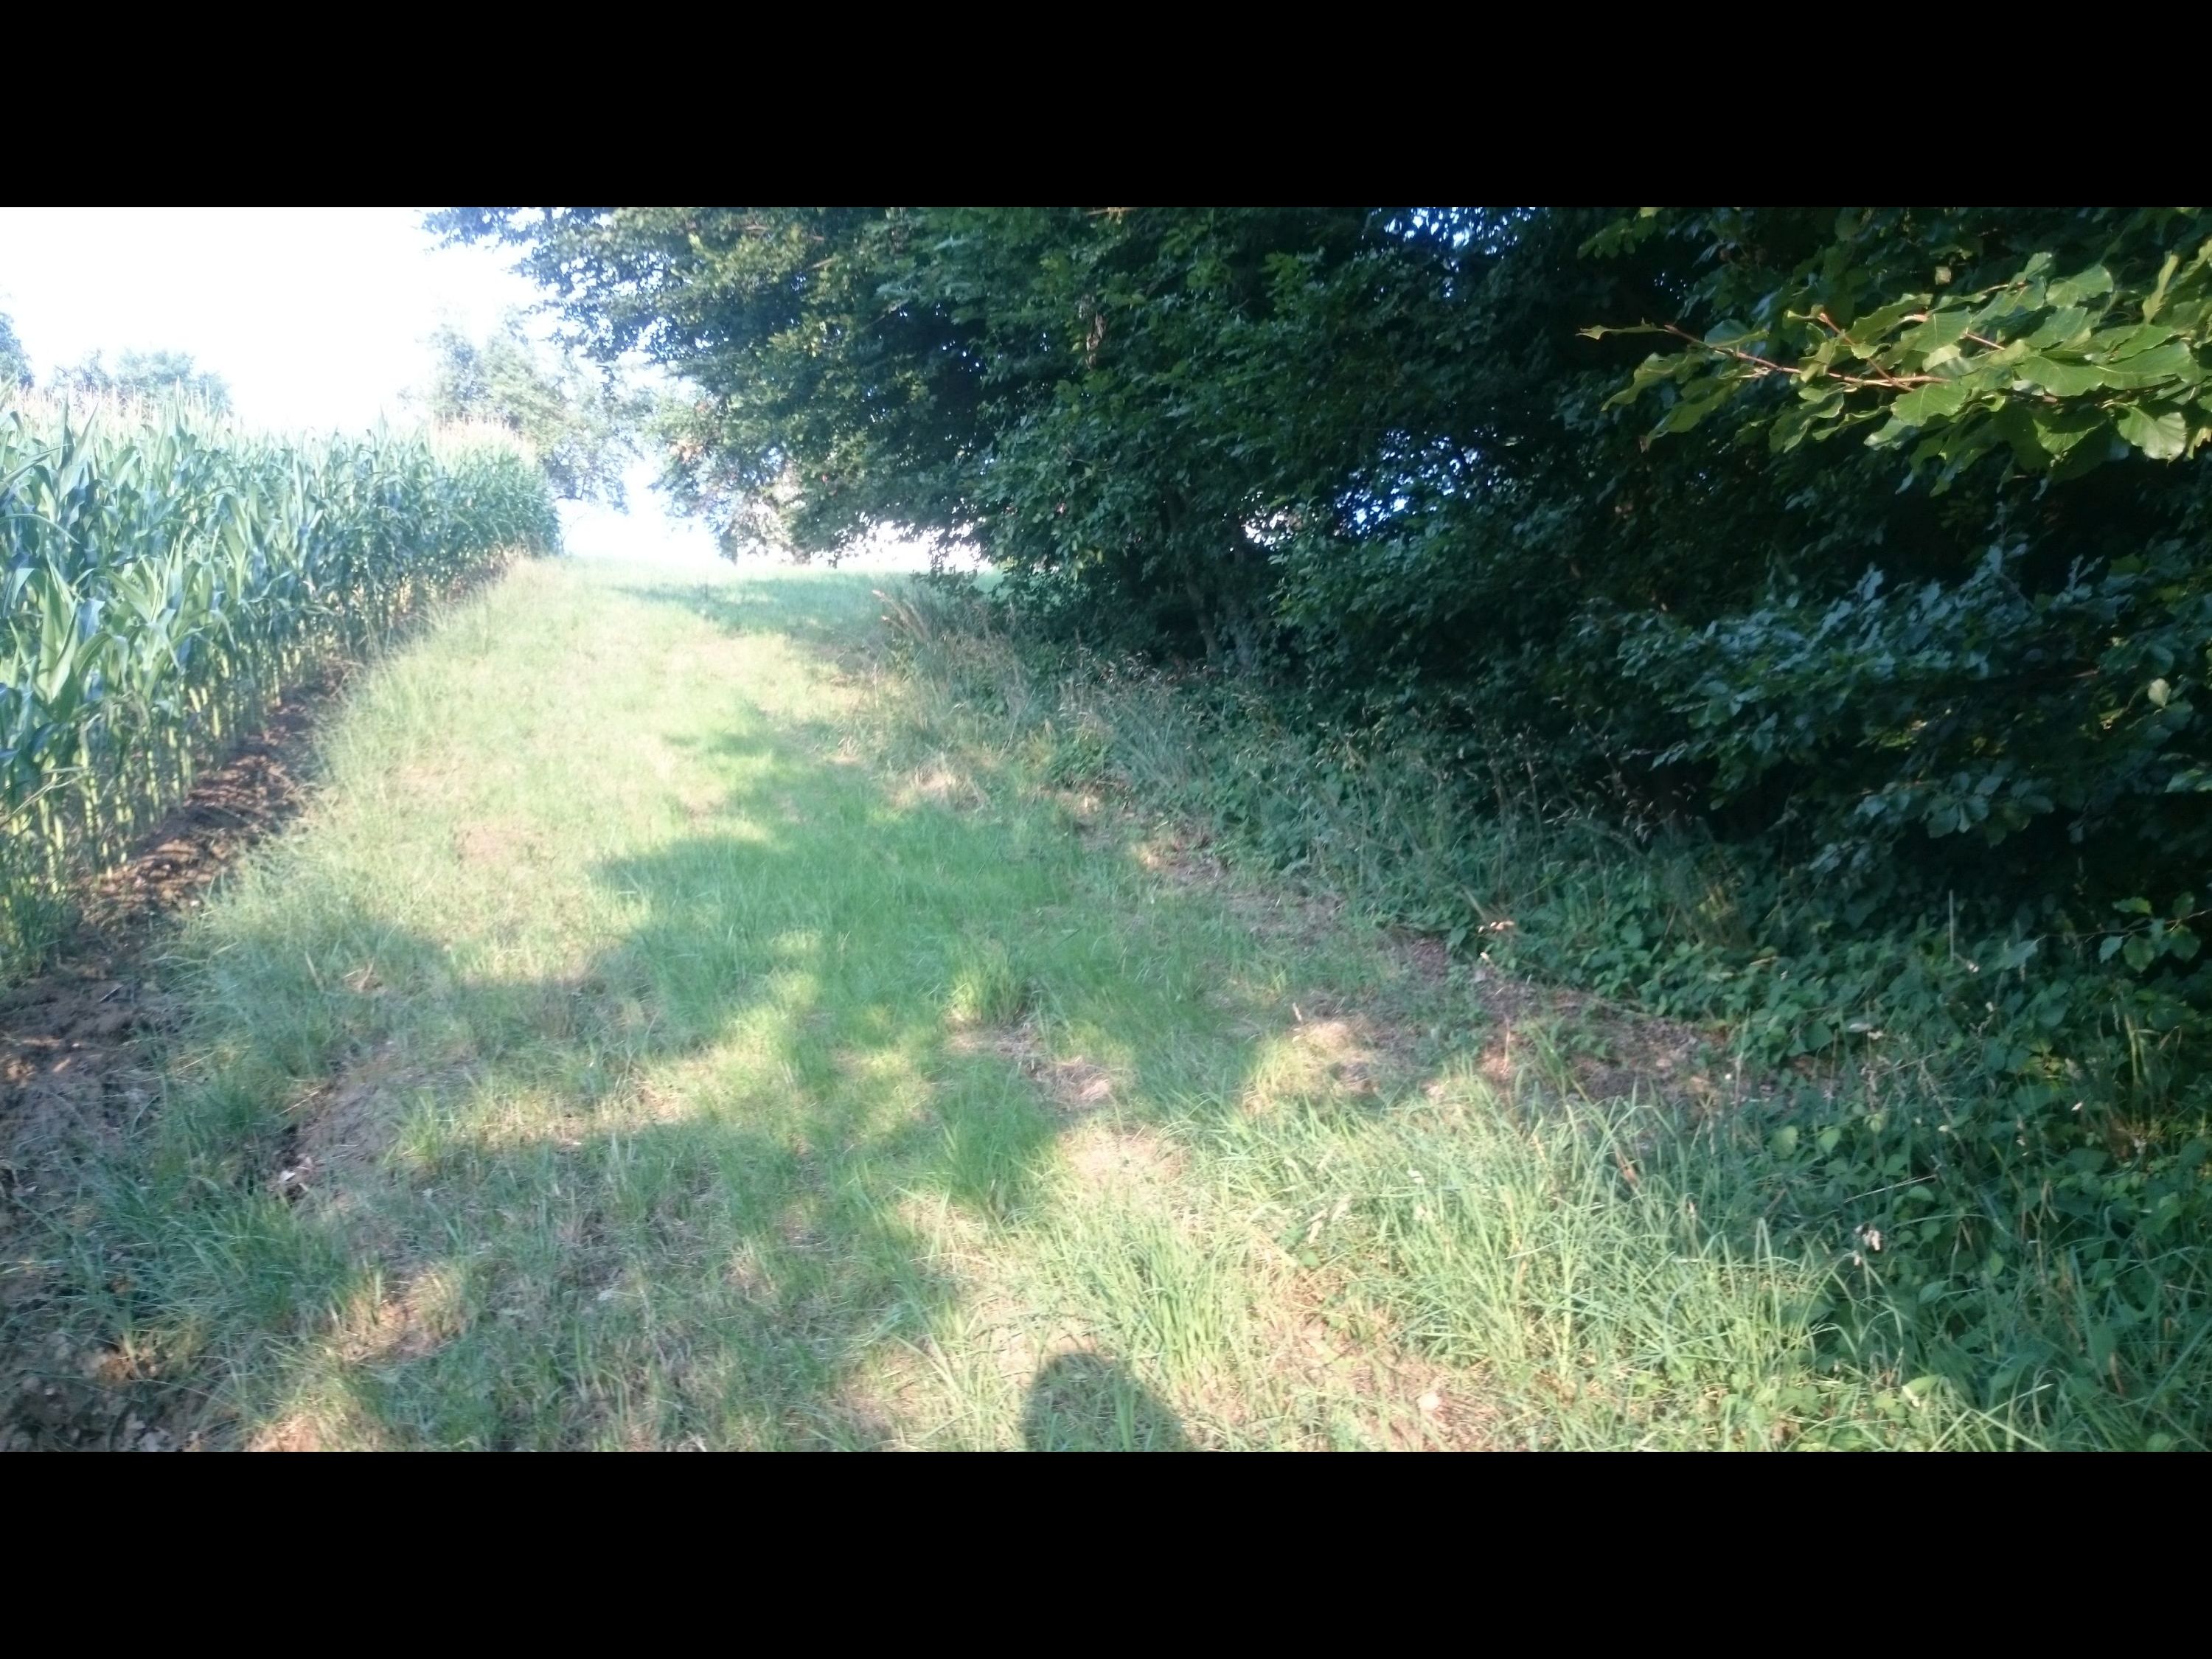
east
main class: Cropland
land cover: Maize
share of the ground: > 75 %
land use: Agriculture (excluding fallow land and kitchen gardens)
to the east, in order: Maize; Grass margins; Paved roads, cycling and walking lanes; Grass margins; Apple fruit; Tracks; Grass margins; Apple fruit; Fences; Grassland without tree/shrub cover; Apple fruit; Electric lines; Apple fruit
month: July
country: AT
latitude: 47.0708
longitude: 15.9400
